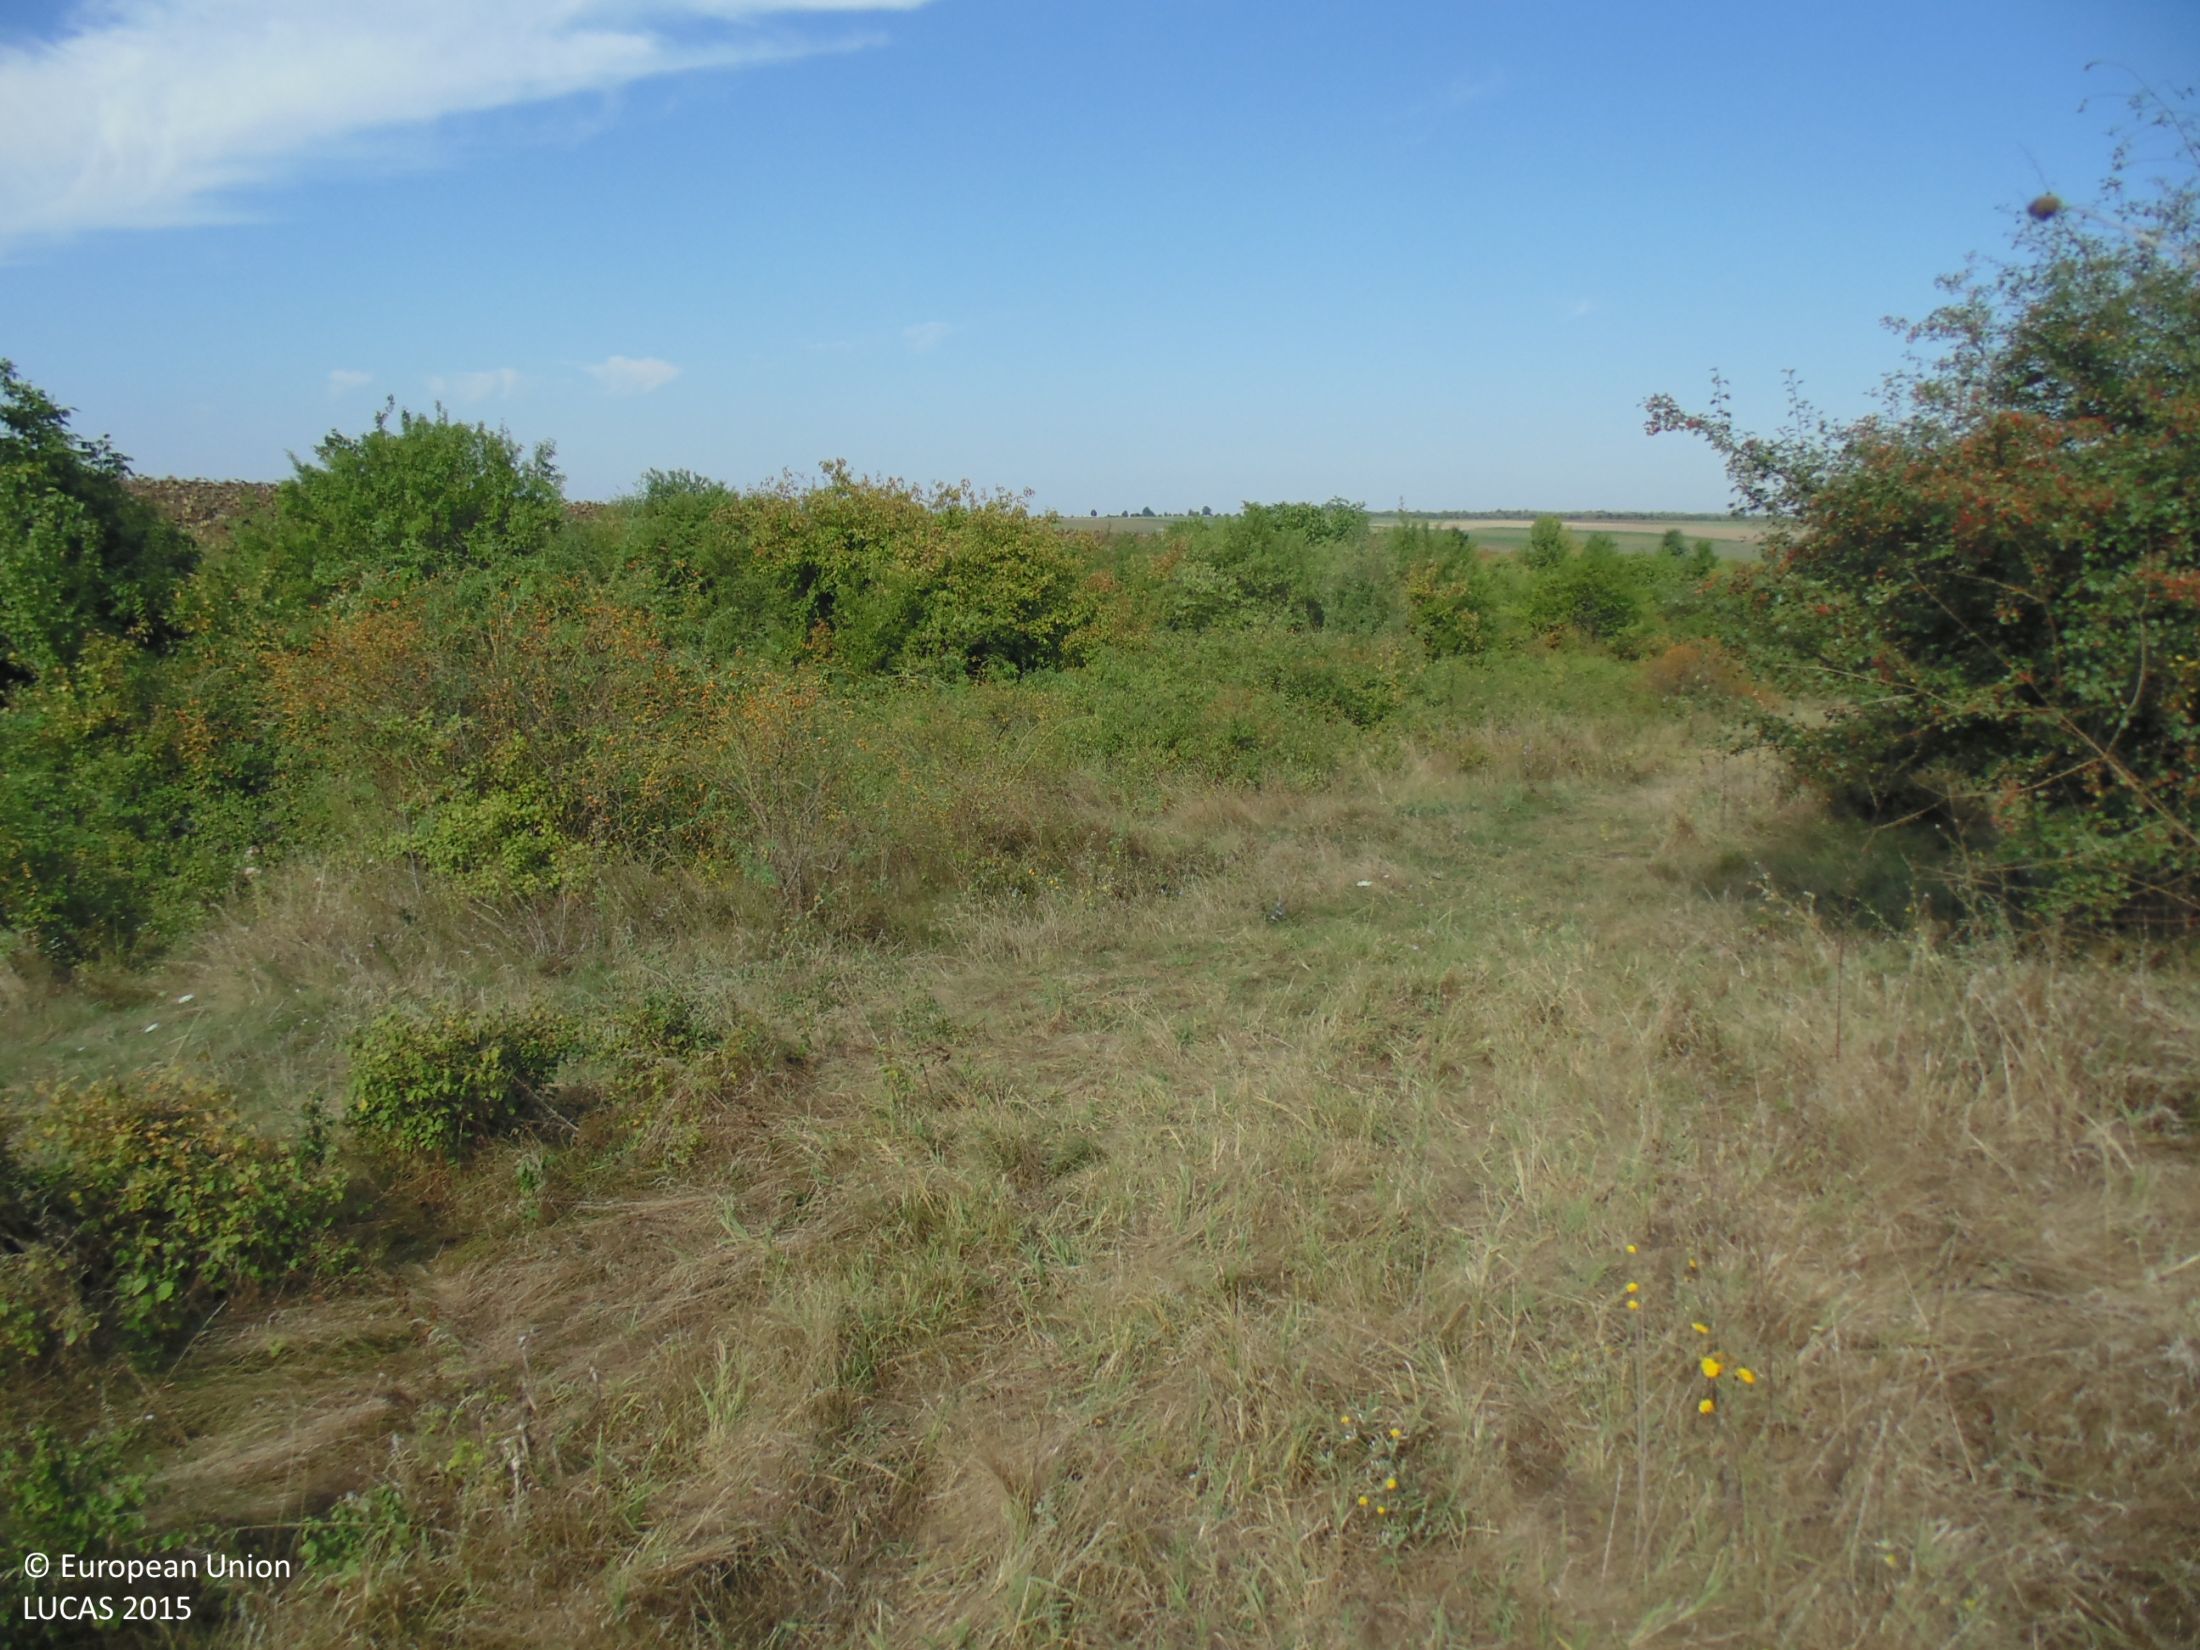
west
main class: Grassland
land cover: Grassland with sparse tree/shrub cover
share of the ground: > 75 %
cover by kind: herbaceous plants 90 %, broadleaved forest trees 5 %, shrubs 5 %
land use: Semi-natural and natural areas not in use
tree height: < 5 m
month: September
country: BG
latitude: 43.8518
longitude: 27.1305
